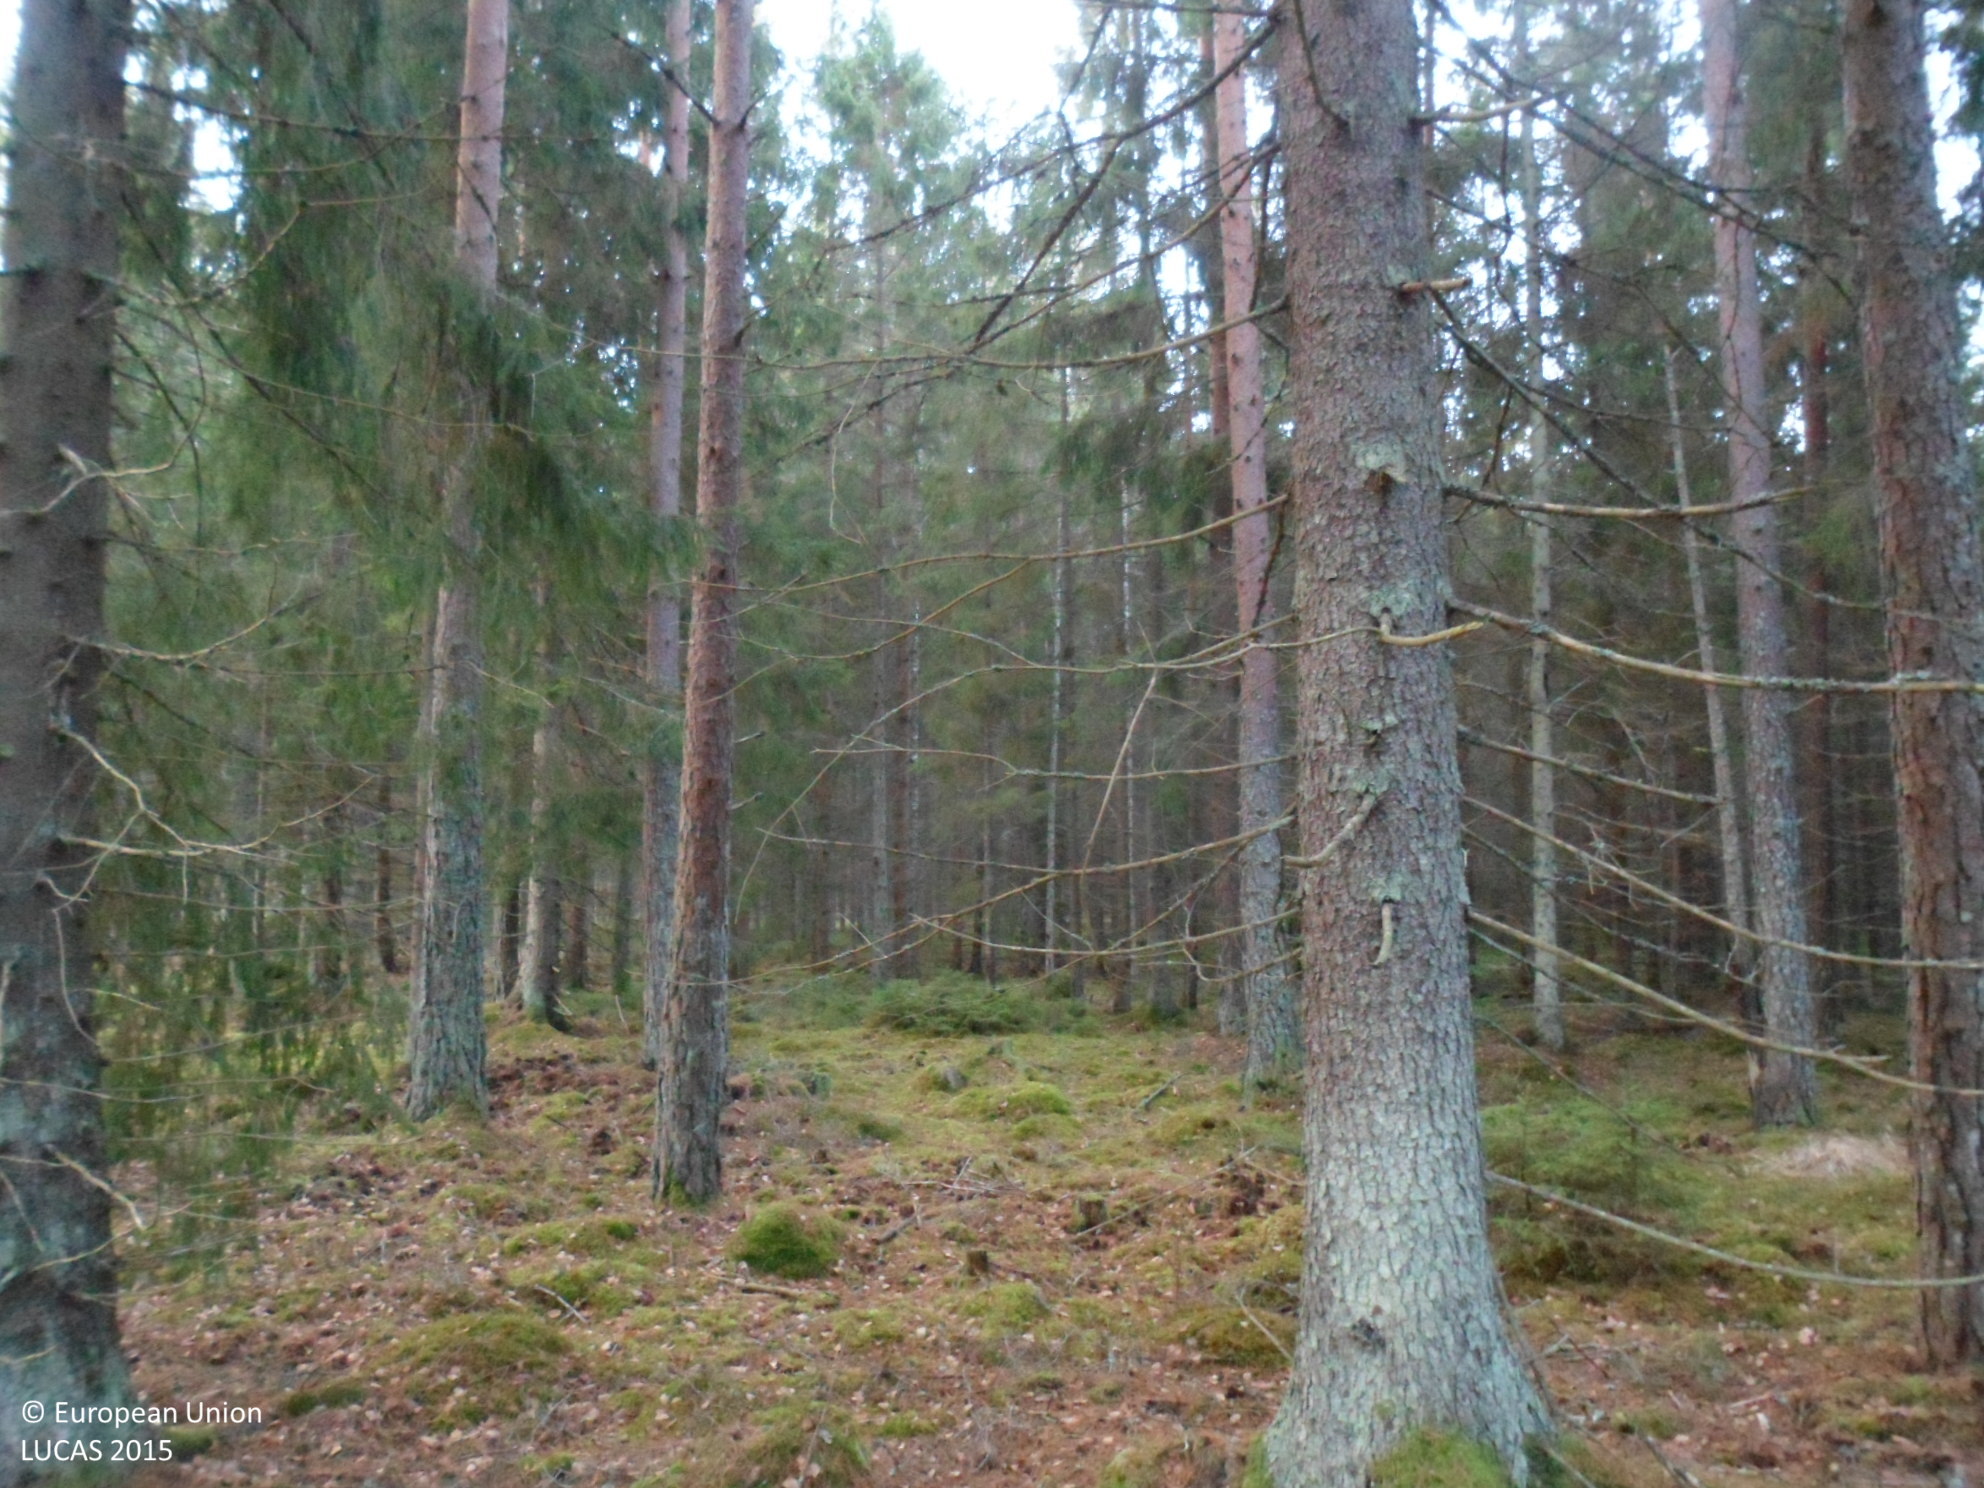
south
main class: Woodland
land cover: Spruce dominated coniferous woodland
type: boreal forest
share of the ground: 50 - 75 %
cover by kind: coniferous forest trees 60 %, lichens and mosses 25 %, shrubs 10 %, unconsolidated bare surface 5 %
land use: Forestry
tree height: > 5 m
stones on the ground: < 10 %
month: November
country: SE
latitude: 56.7507
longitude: 16.0014
